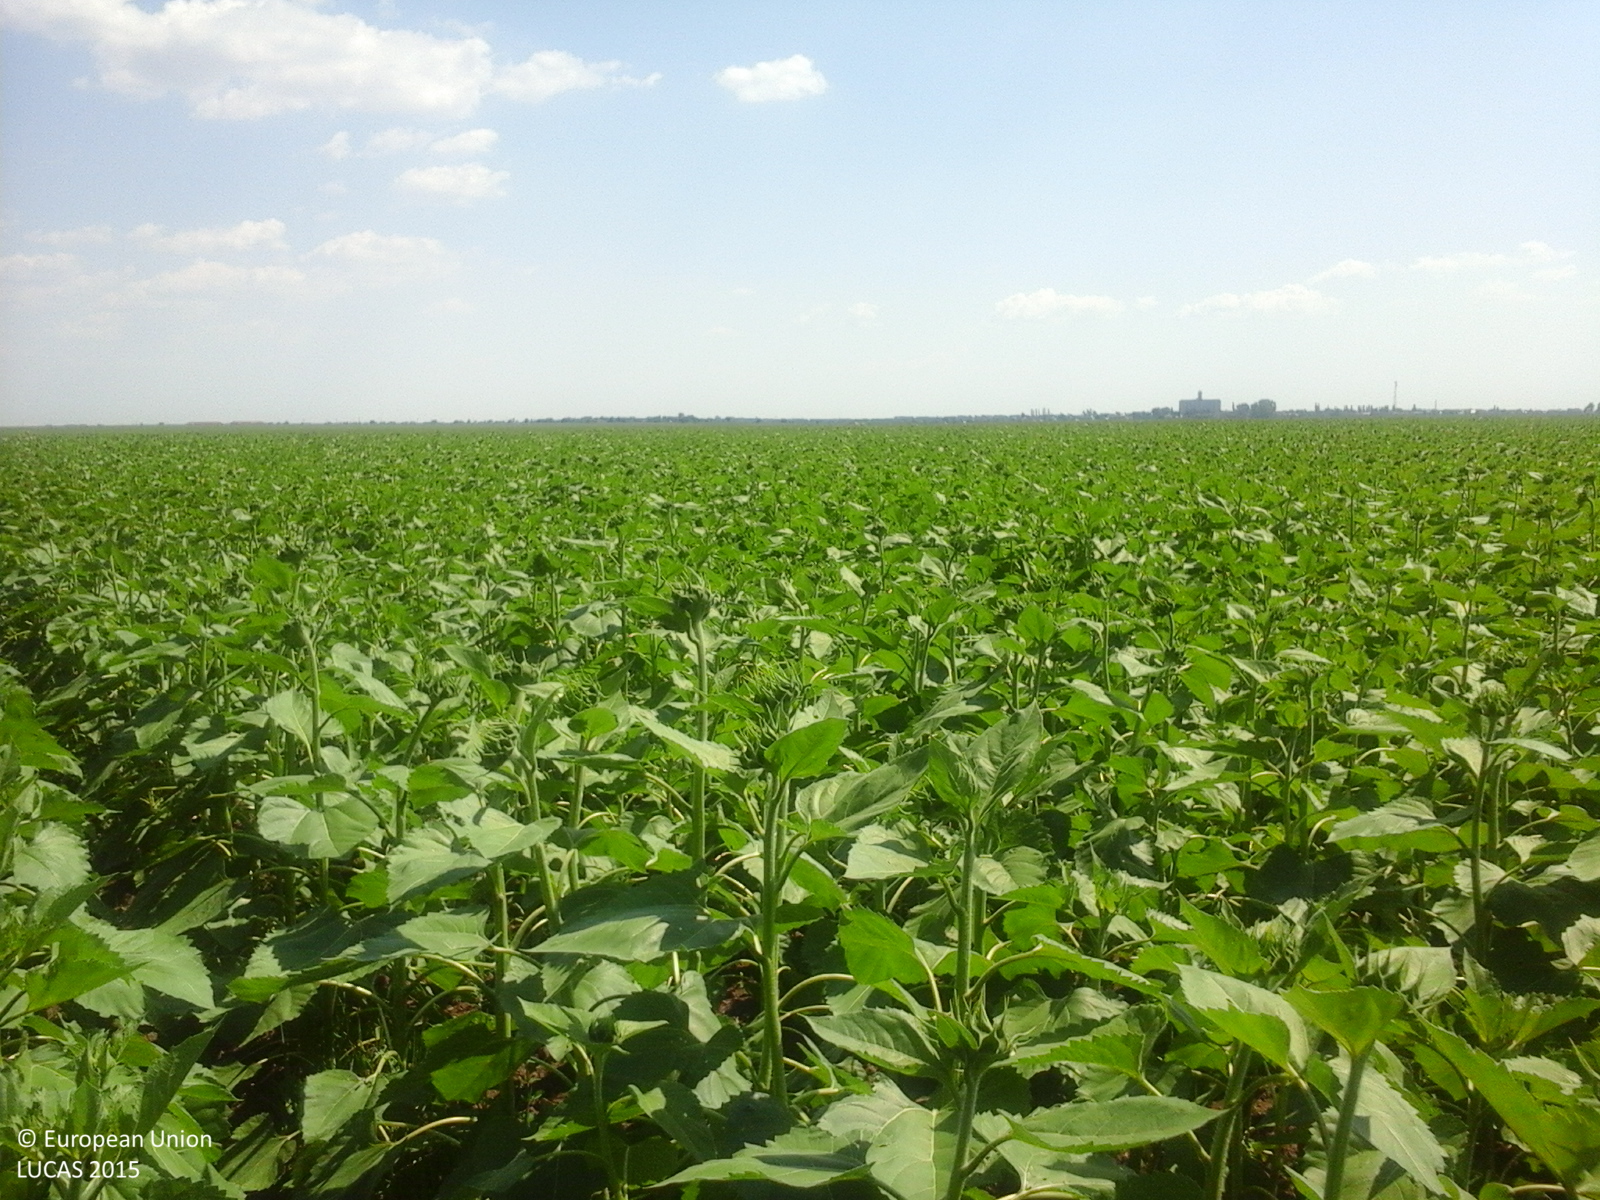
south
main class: Cropland
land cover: Sunflower
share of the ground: > 75 %
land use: Agriculture (excluding fallow land and kitchen gardens)
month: July
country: RO
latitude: 44.1414
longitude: 24.6845
